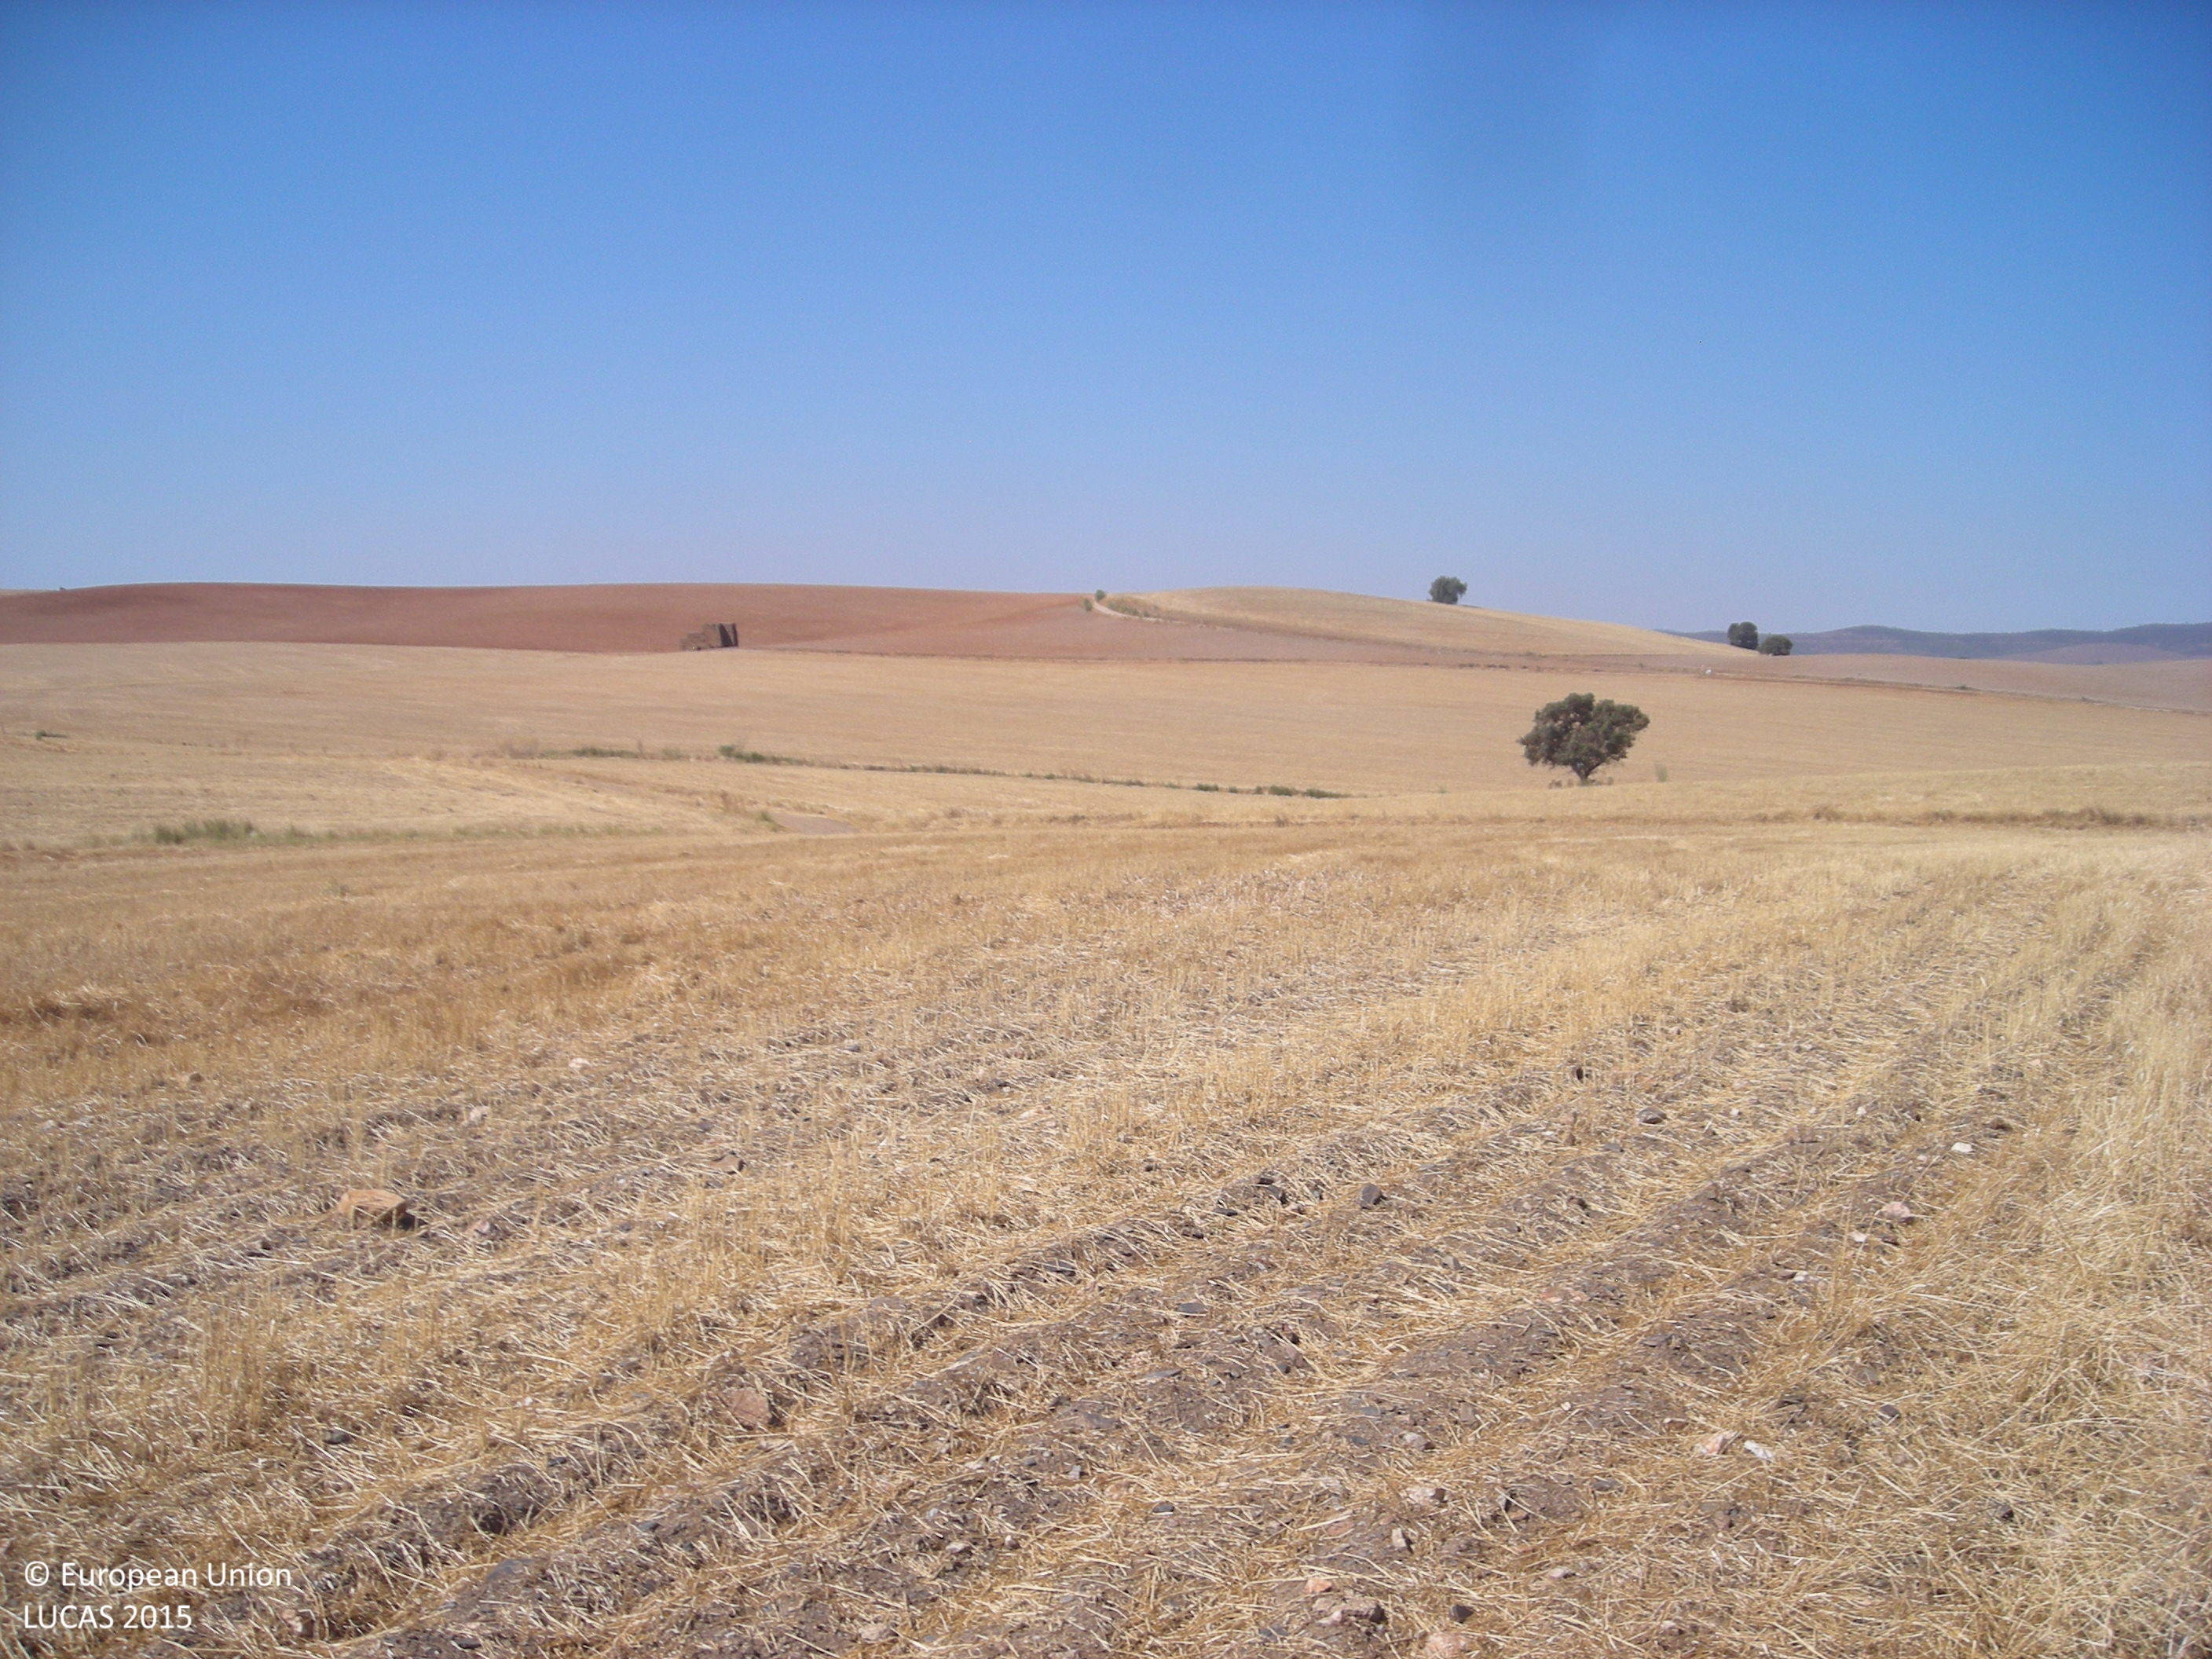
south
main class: Woodland
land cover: Broadleaved woodland
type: broadleaved evergreen forest
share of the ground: > 75 %
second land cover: Grassland without tree/shrub cover
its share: 10 - 25 %
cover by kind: broadleaved forest trees 85 %, herbaceous plants 15 %
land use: Forestry
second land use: Agriculture (excluding fallow land and kitchen gardens)
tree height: > 5 m
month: July
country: ES
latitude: 38.8523
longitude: -5.8919
